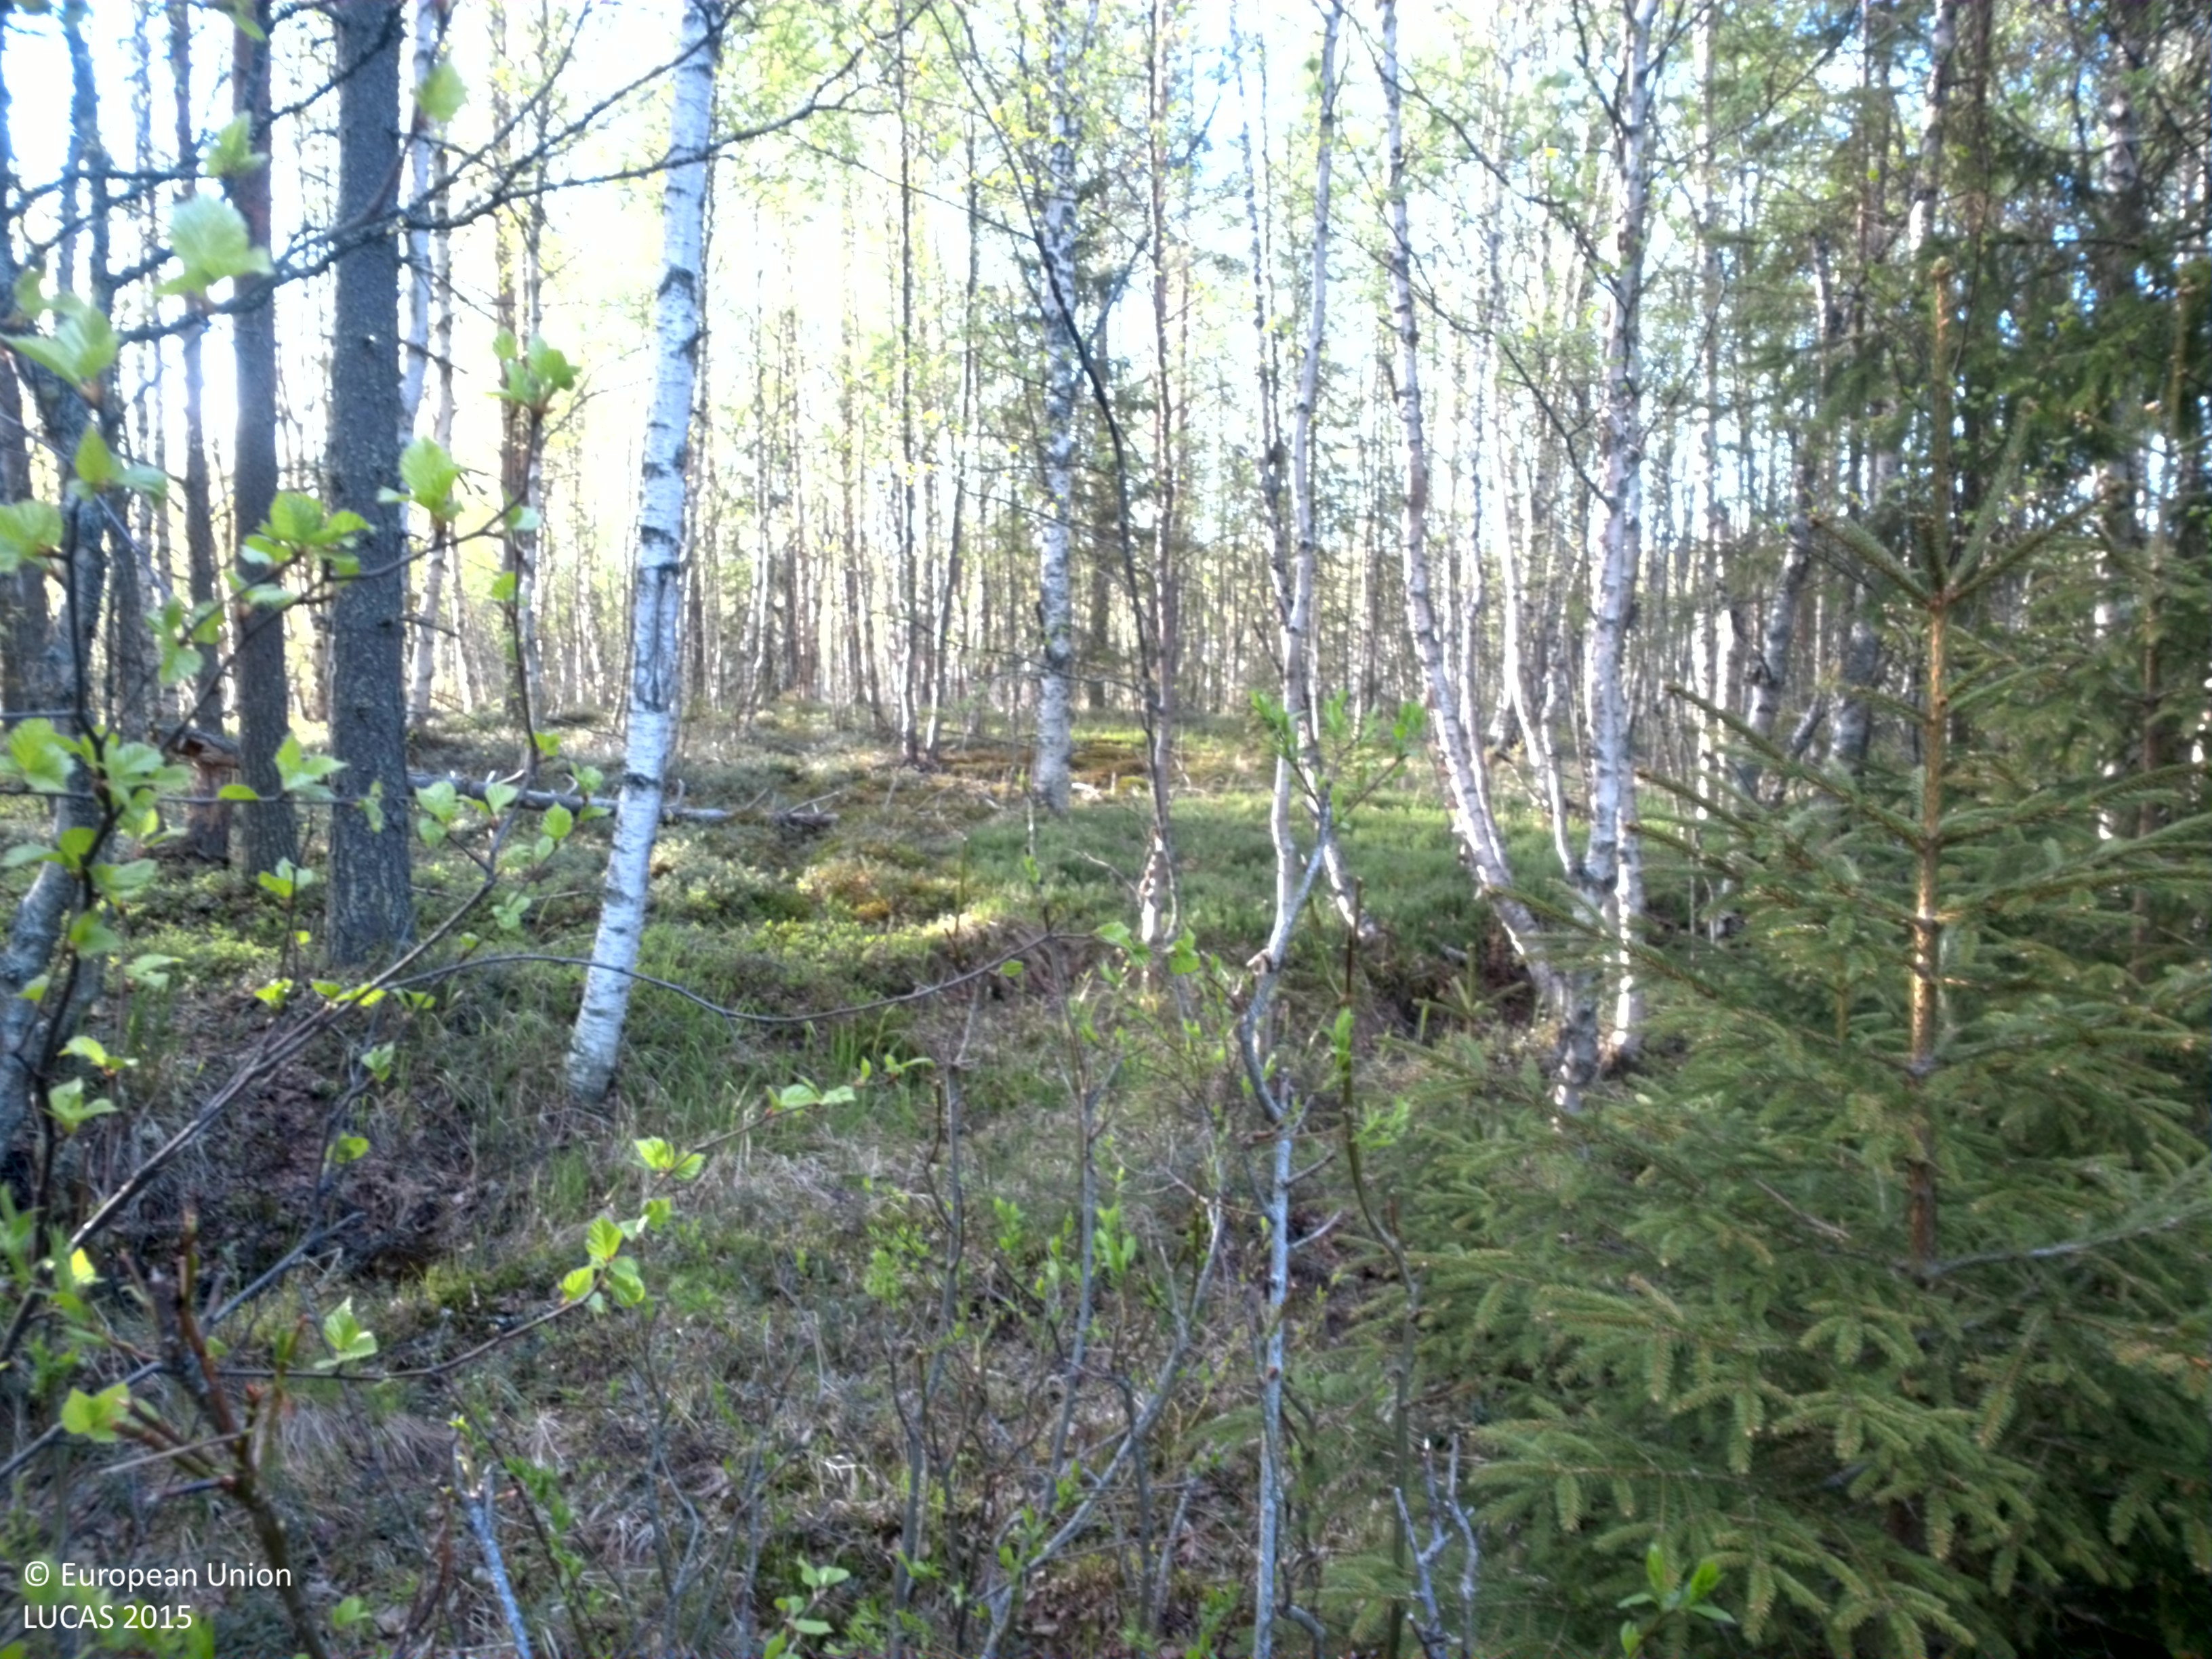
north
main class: Woodland
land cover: Other mixed woodland
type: boreal forest
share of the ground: 25 - 50 %
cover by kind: herbaceous plants 35 %, broadleaved forest trees 30 %, shrubs 20 %, coniferous forest trees 10 %
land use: Forestry
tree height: > 5 m
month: June
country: SE
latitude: 64.2212
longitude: 17.4914
